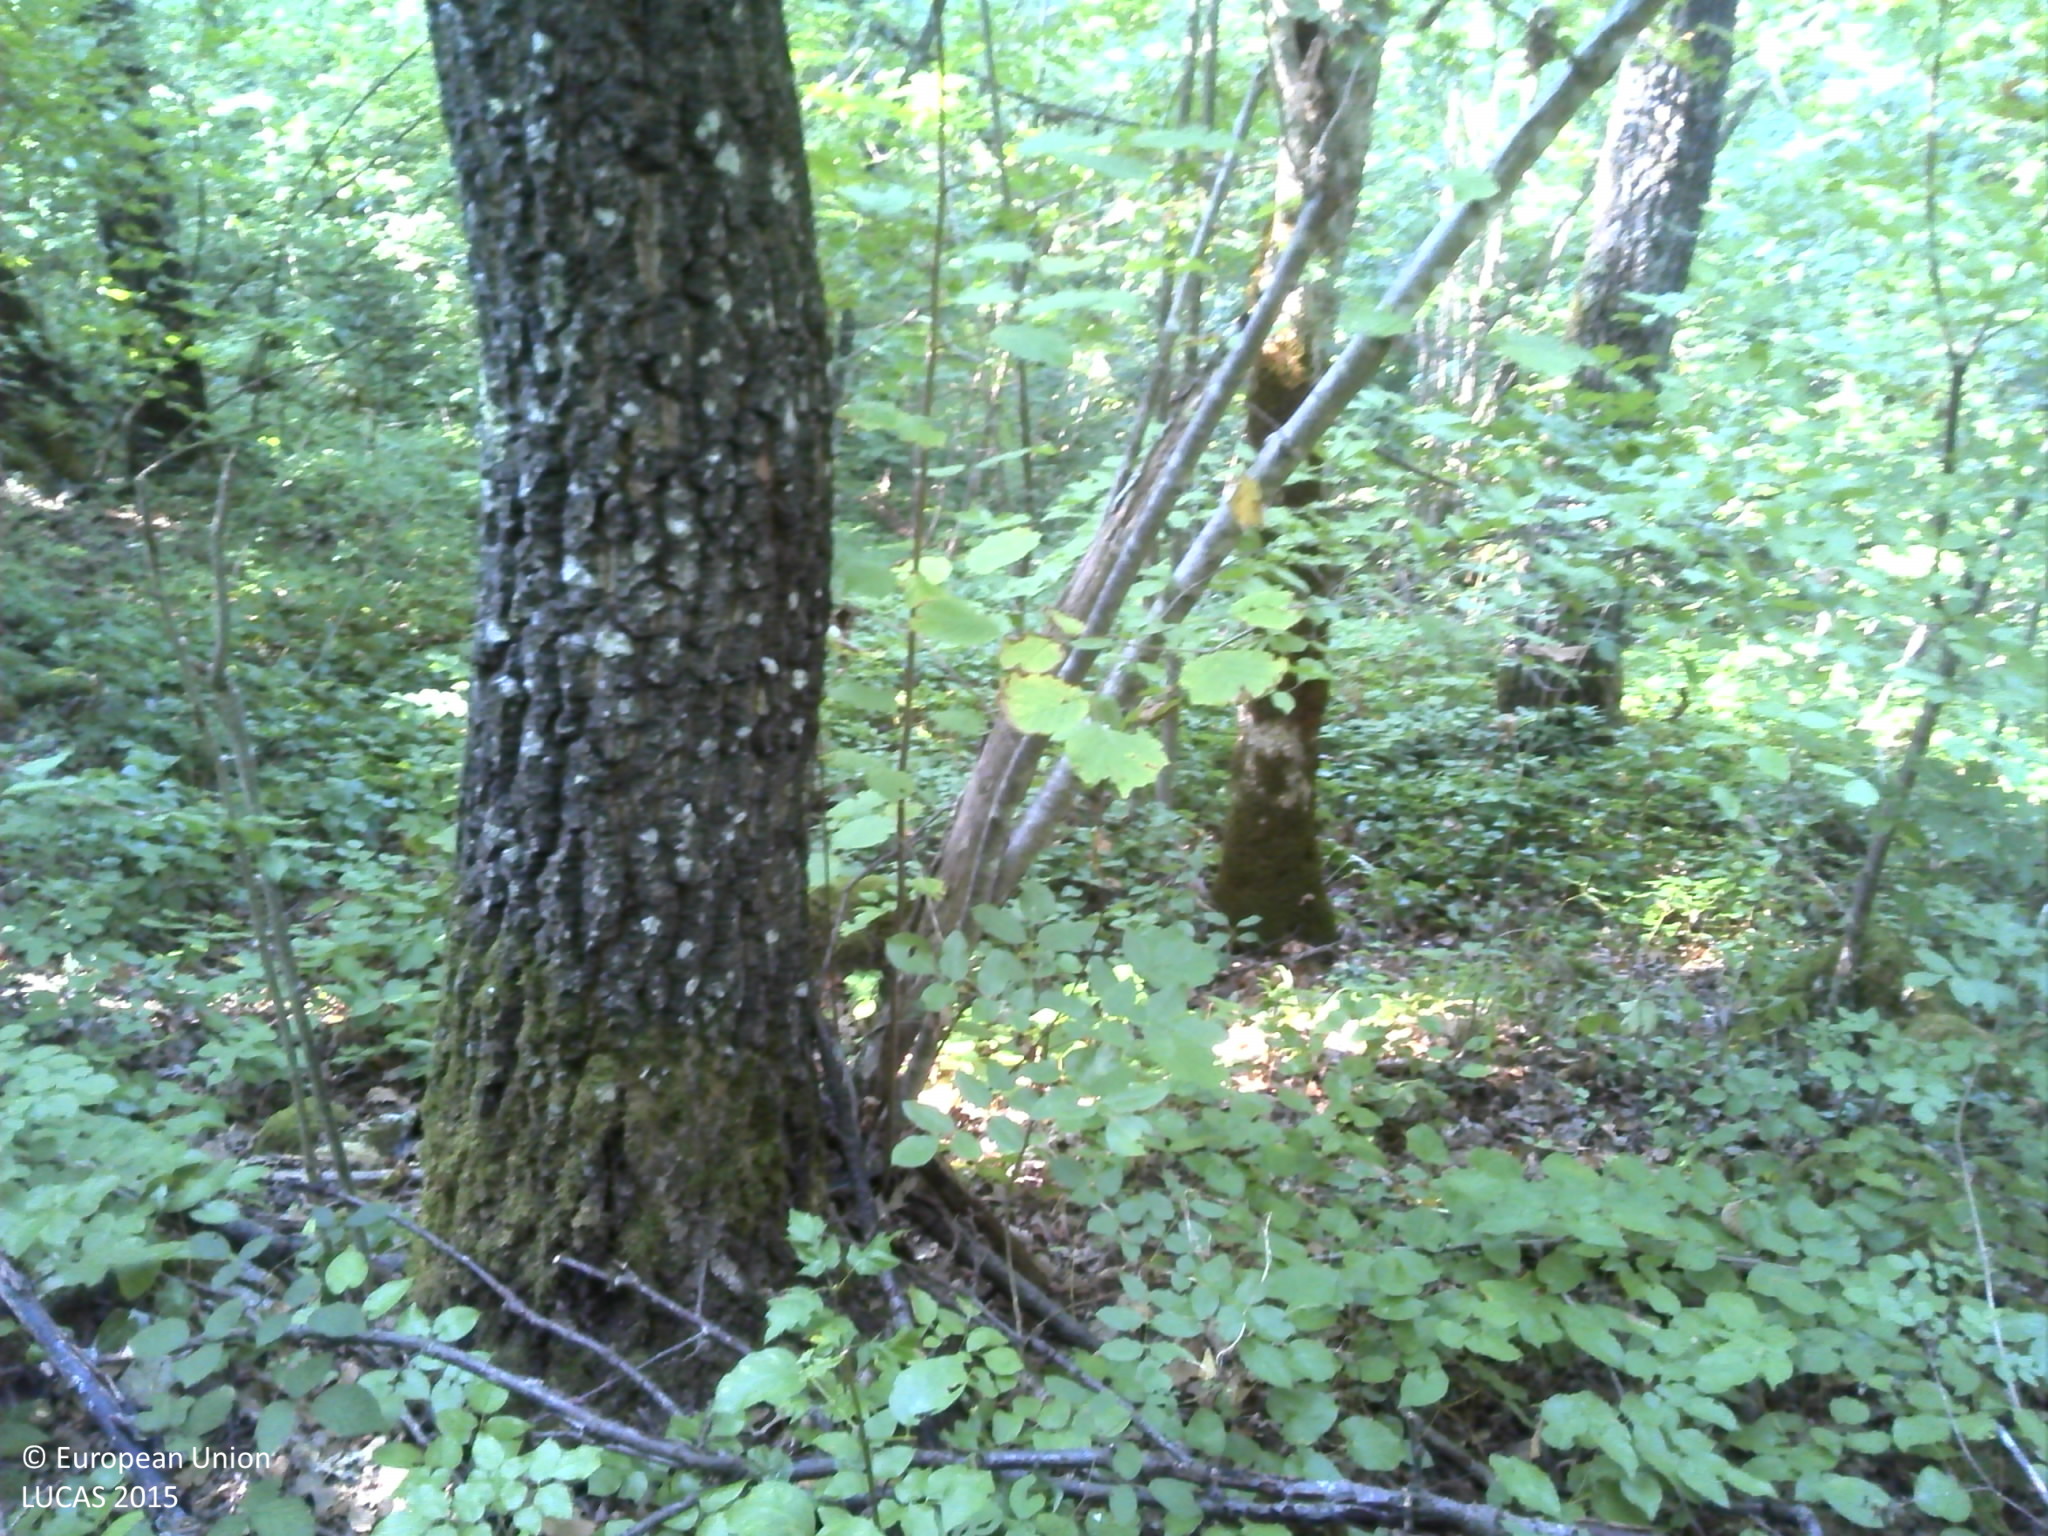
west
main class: Woodland
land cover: Broadleaved woodland
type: acidophilous oak and oak-birch forest
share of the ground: > 75 %
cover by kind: broadleaved forest trees 100 %
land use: Forestry
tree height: > 5 m
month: September
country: HR
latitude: 45.3356
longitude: 15.2912
